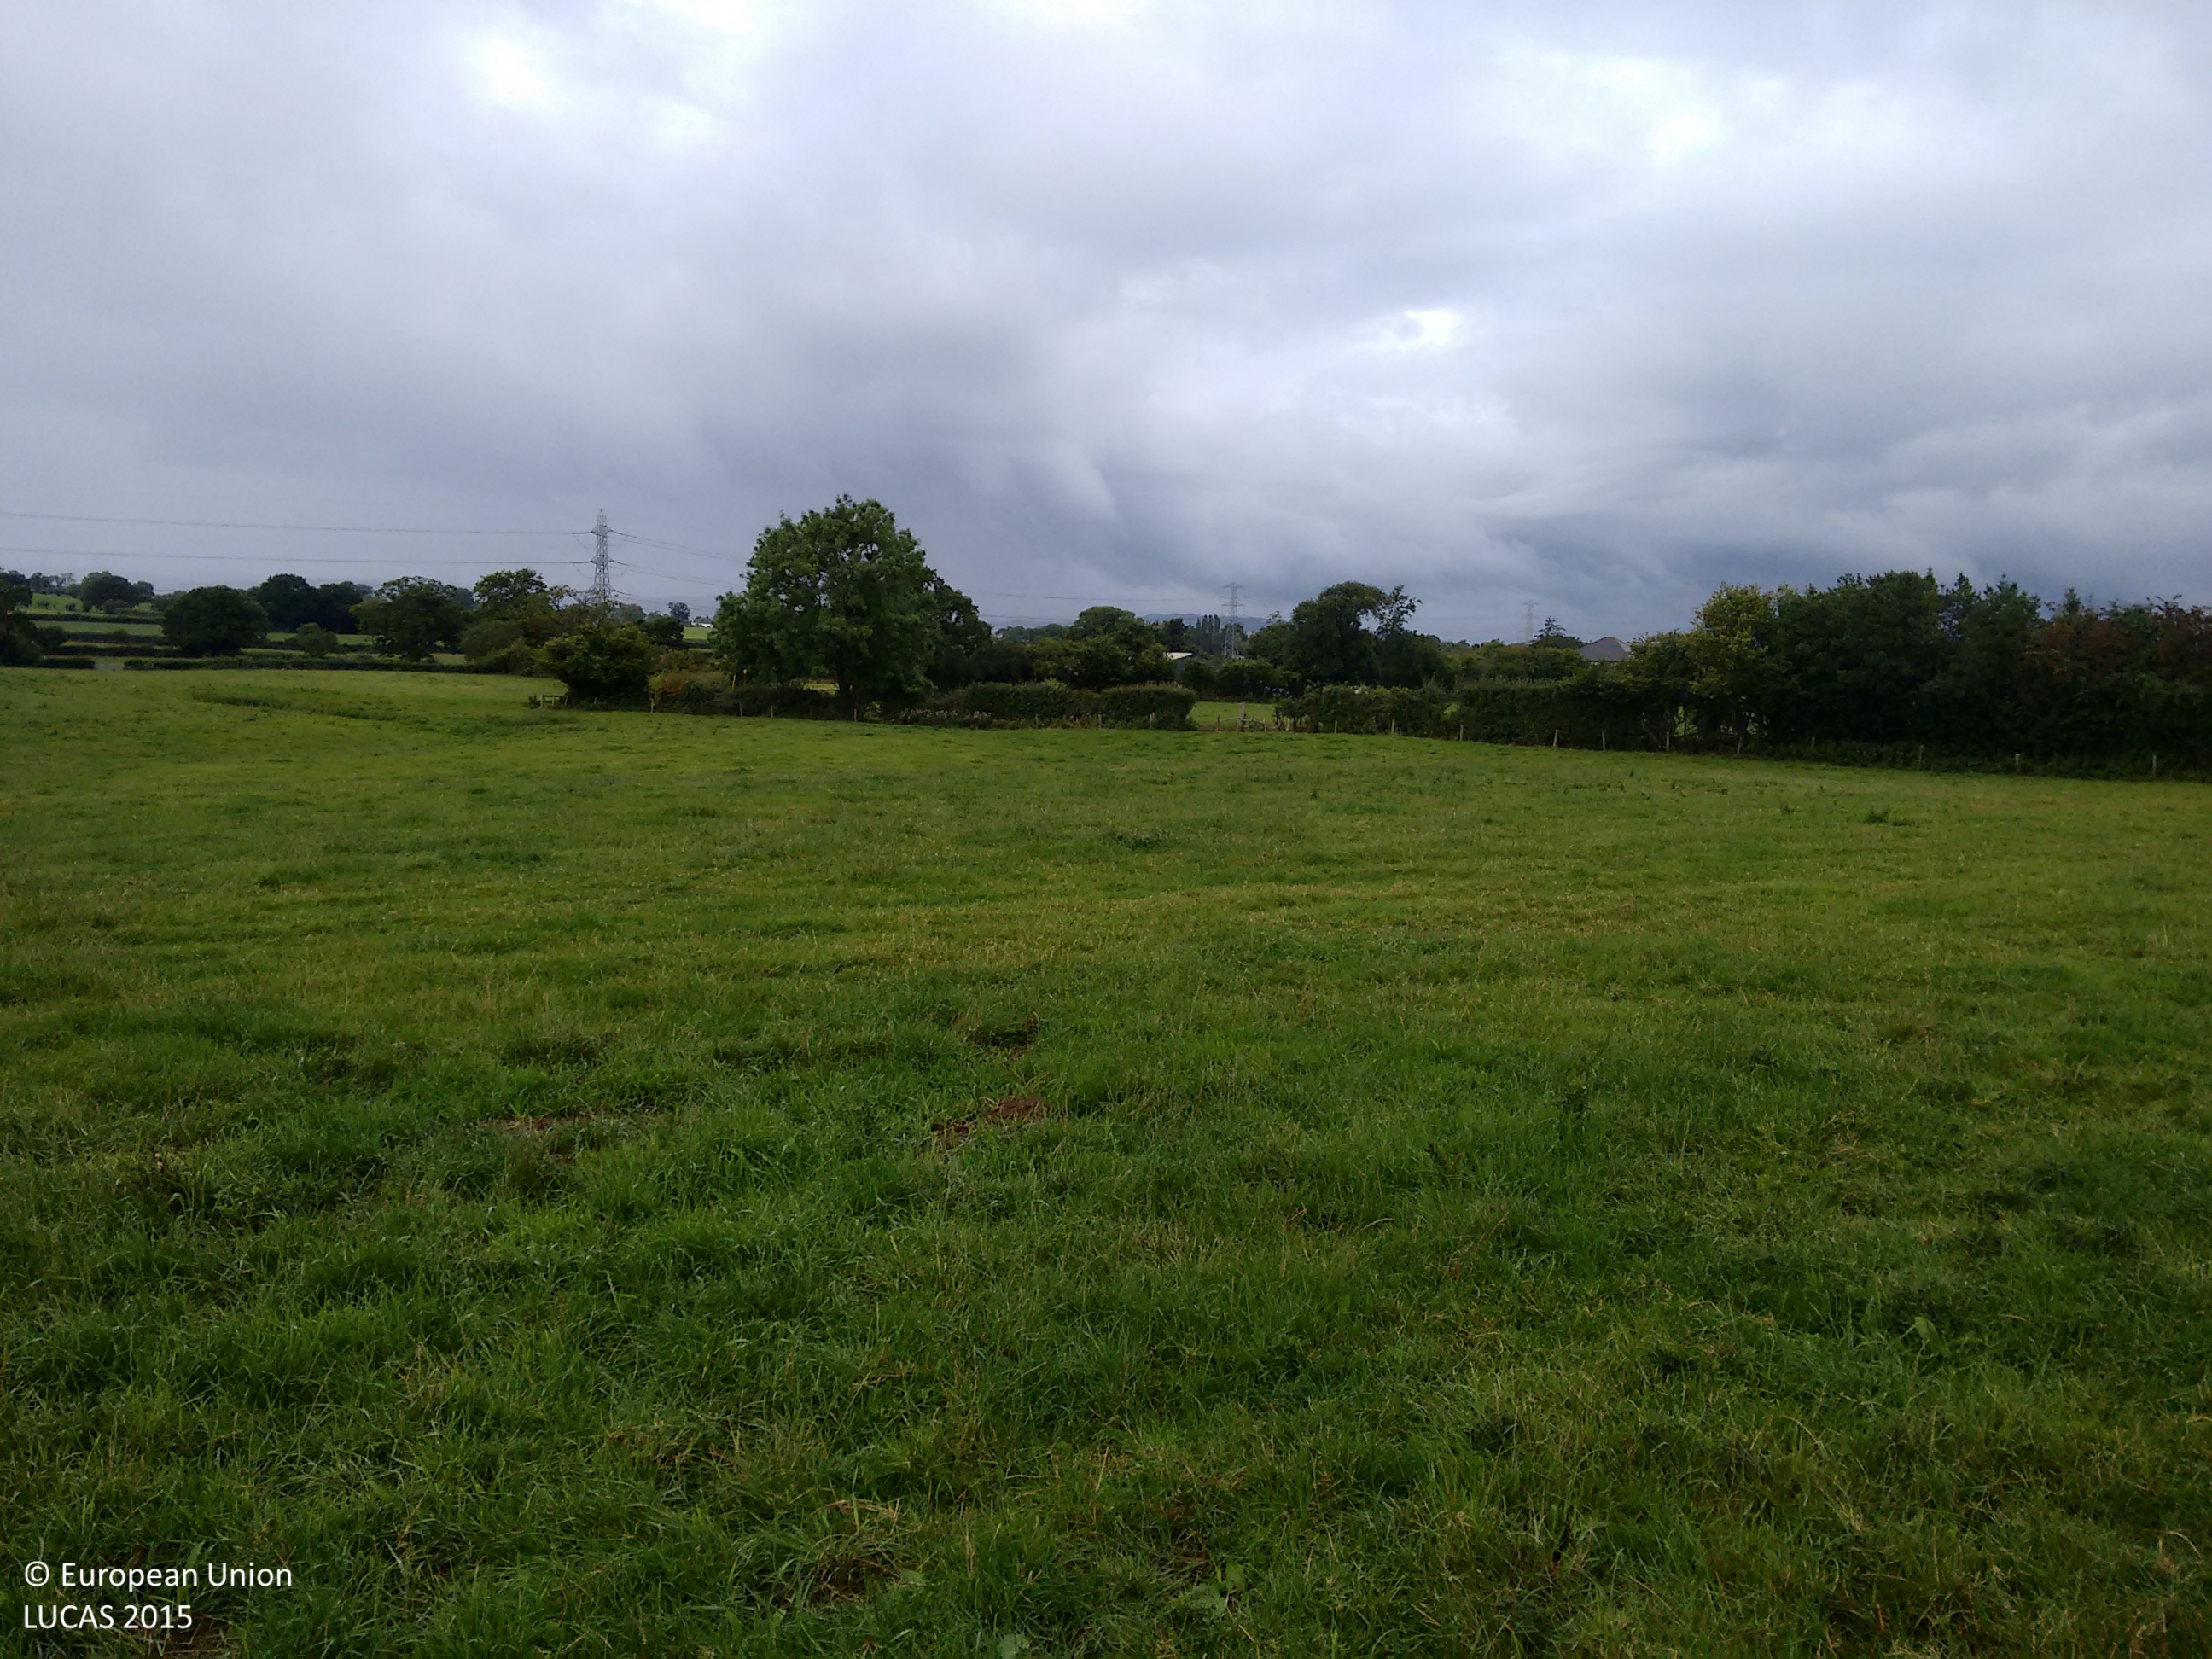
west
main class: Grassland
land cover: Grassland without tree/shrub cover
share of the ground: > 75 %
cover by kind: herbaceous plants 100 %
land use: Agriculture (excluding fallow land and kitchen gardens)
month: September
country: GB
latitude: 52.9370
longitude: -2.9743
